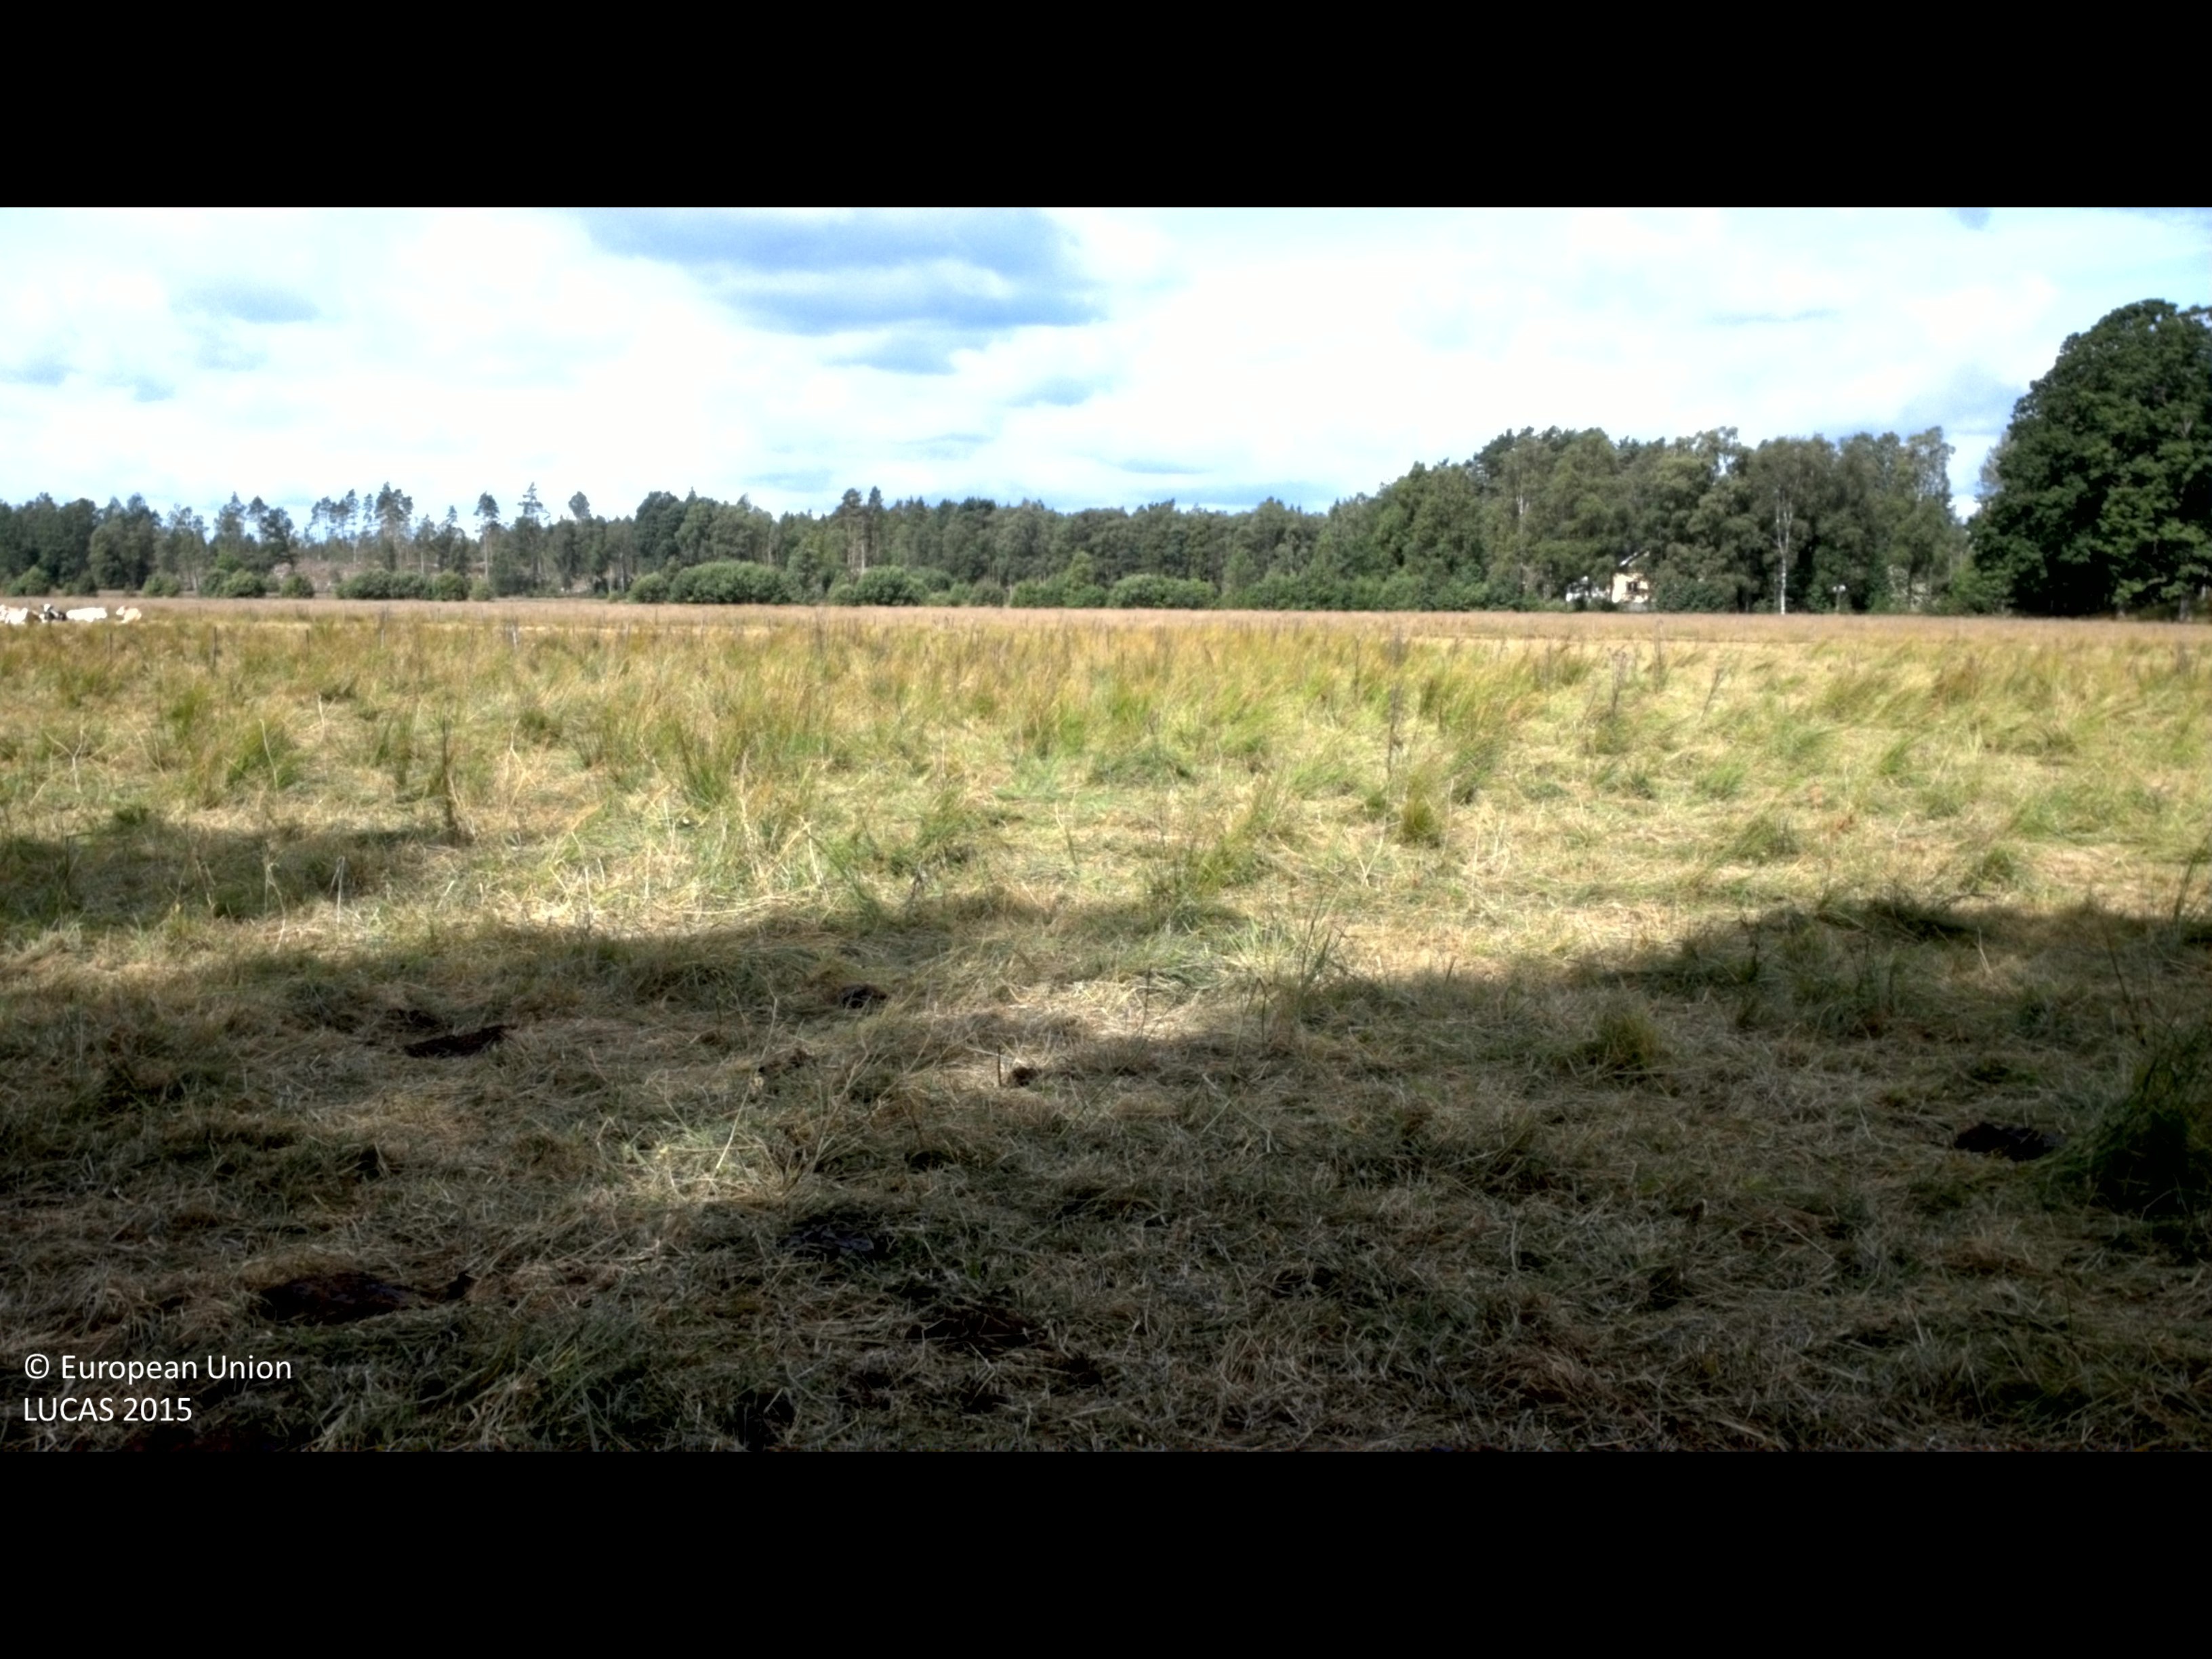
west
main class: Grassland
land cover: Grassland without tree/shrub cover
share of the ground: > 75 %
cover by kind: herbaceous plants 100 %
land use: Agriculture (excluding fallow land and kitchen gardens)
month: July
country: SE
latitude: 56.5476
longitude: 14.3077
